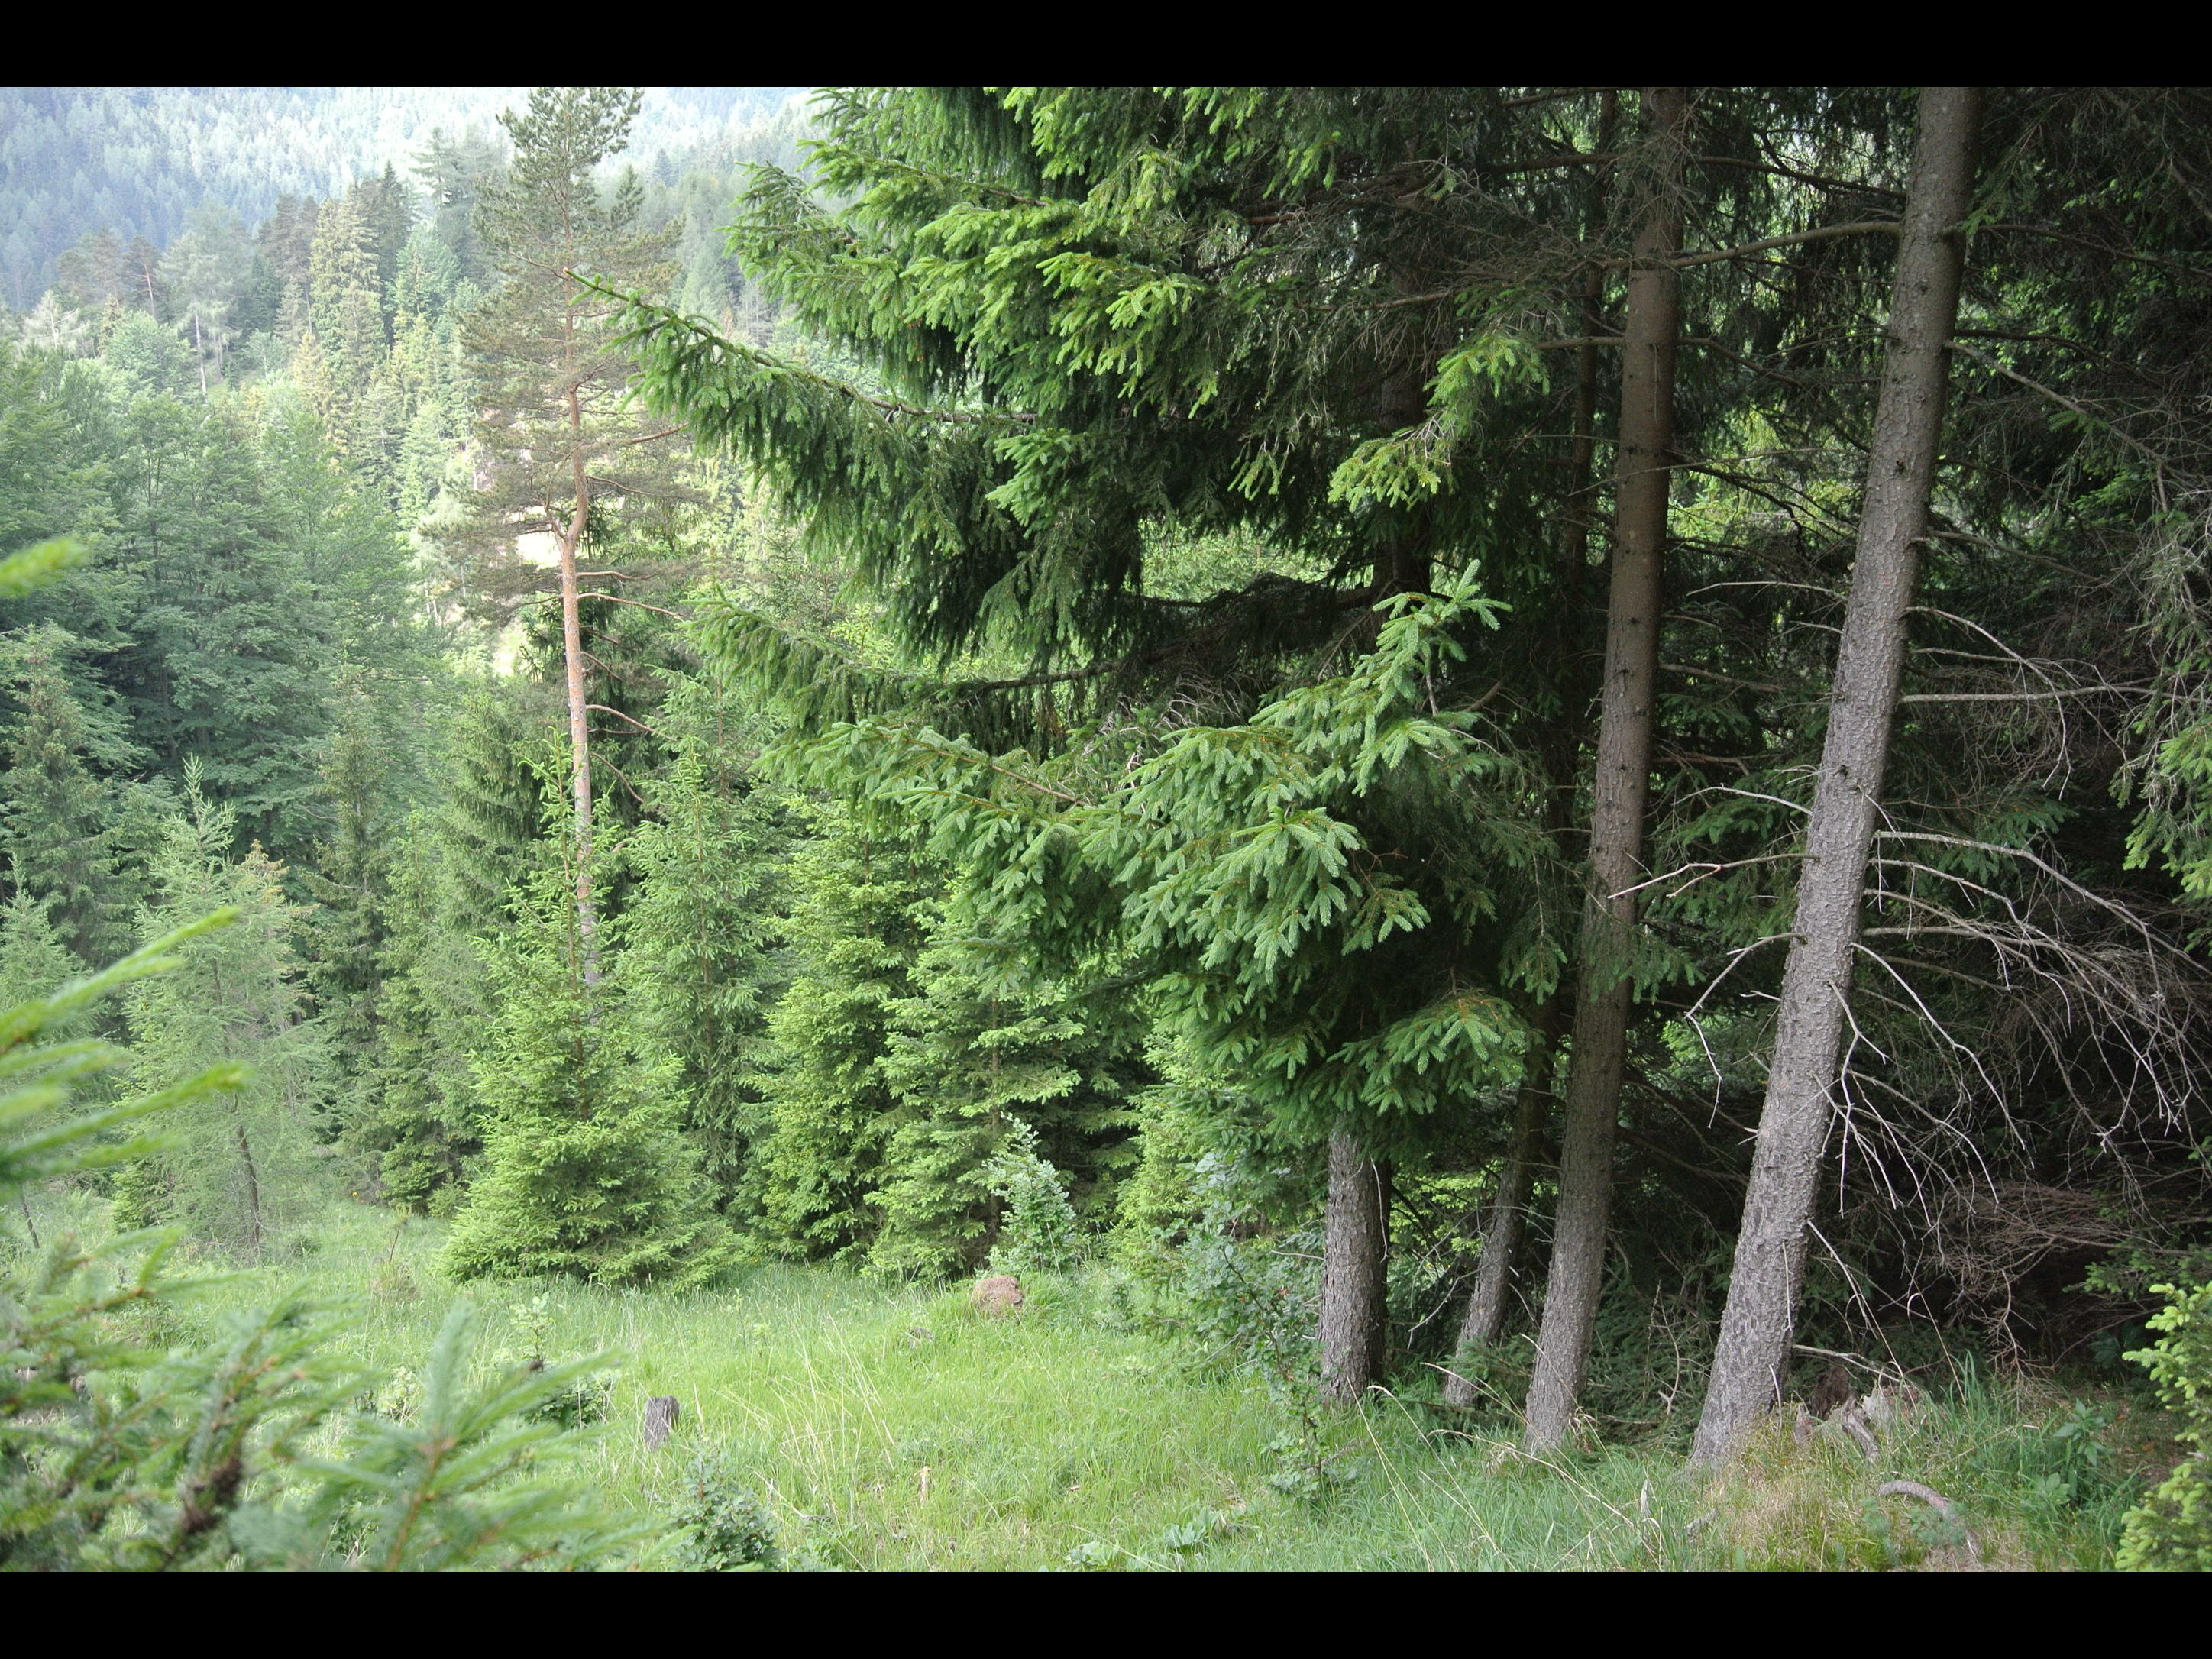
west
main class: Woodland
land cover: Spruce dominated coniferous woodland
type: alpine coniferous forest
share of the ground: > 75 %
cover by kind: coniferous forest trees 90 %, herbaceous plants 10 %
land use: Forestry
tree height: > 5 m
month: June
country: AT
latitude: 47.9281
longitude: 15.7710
